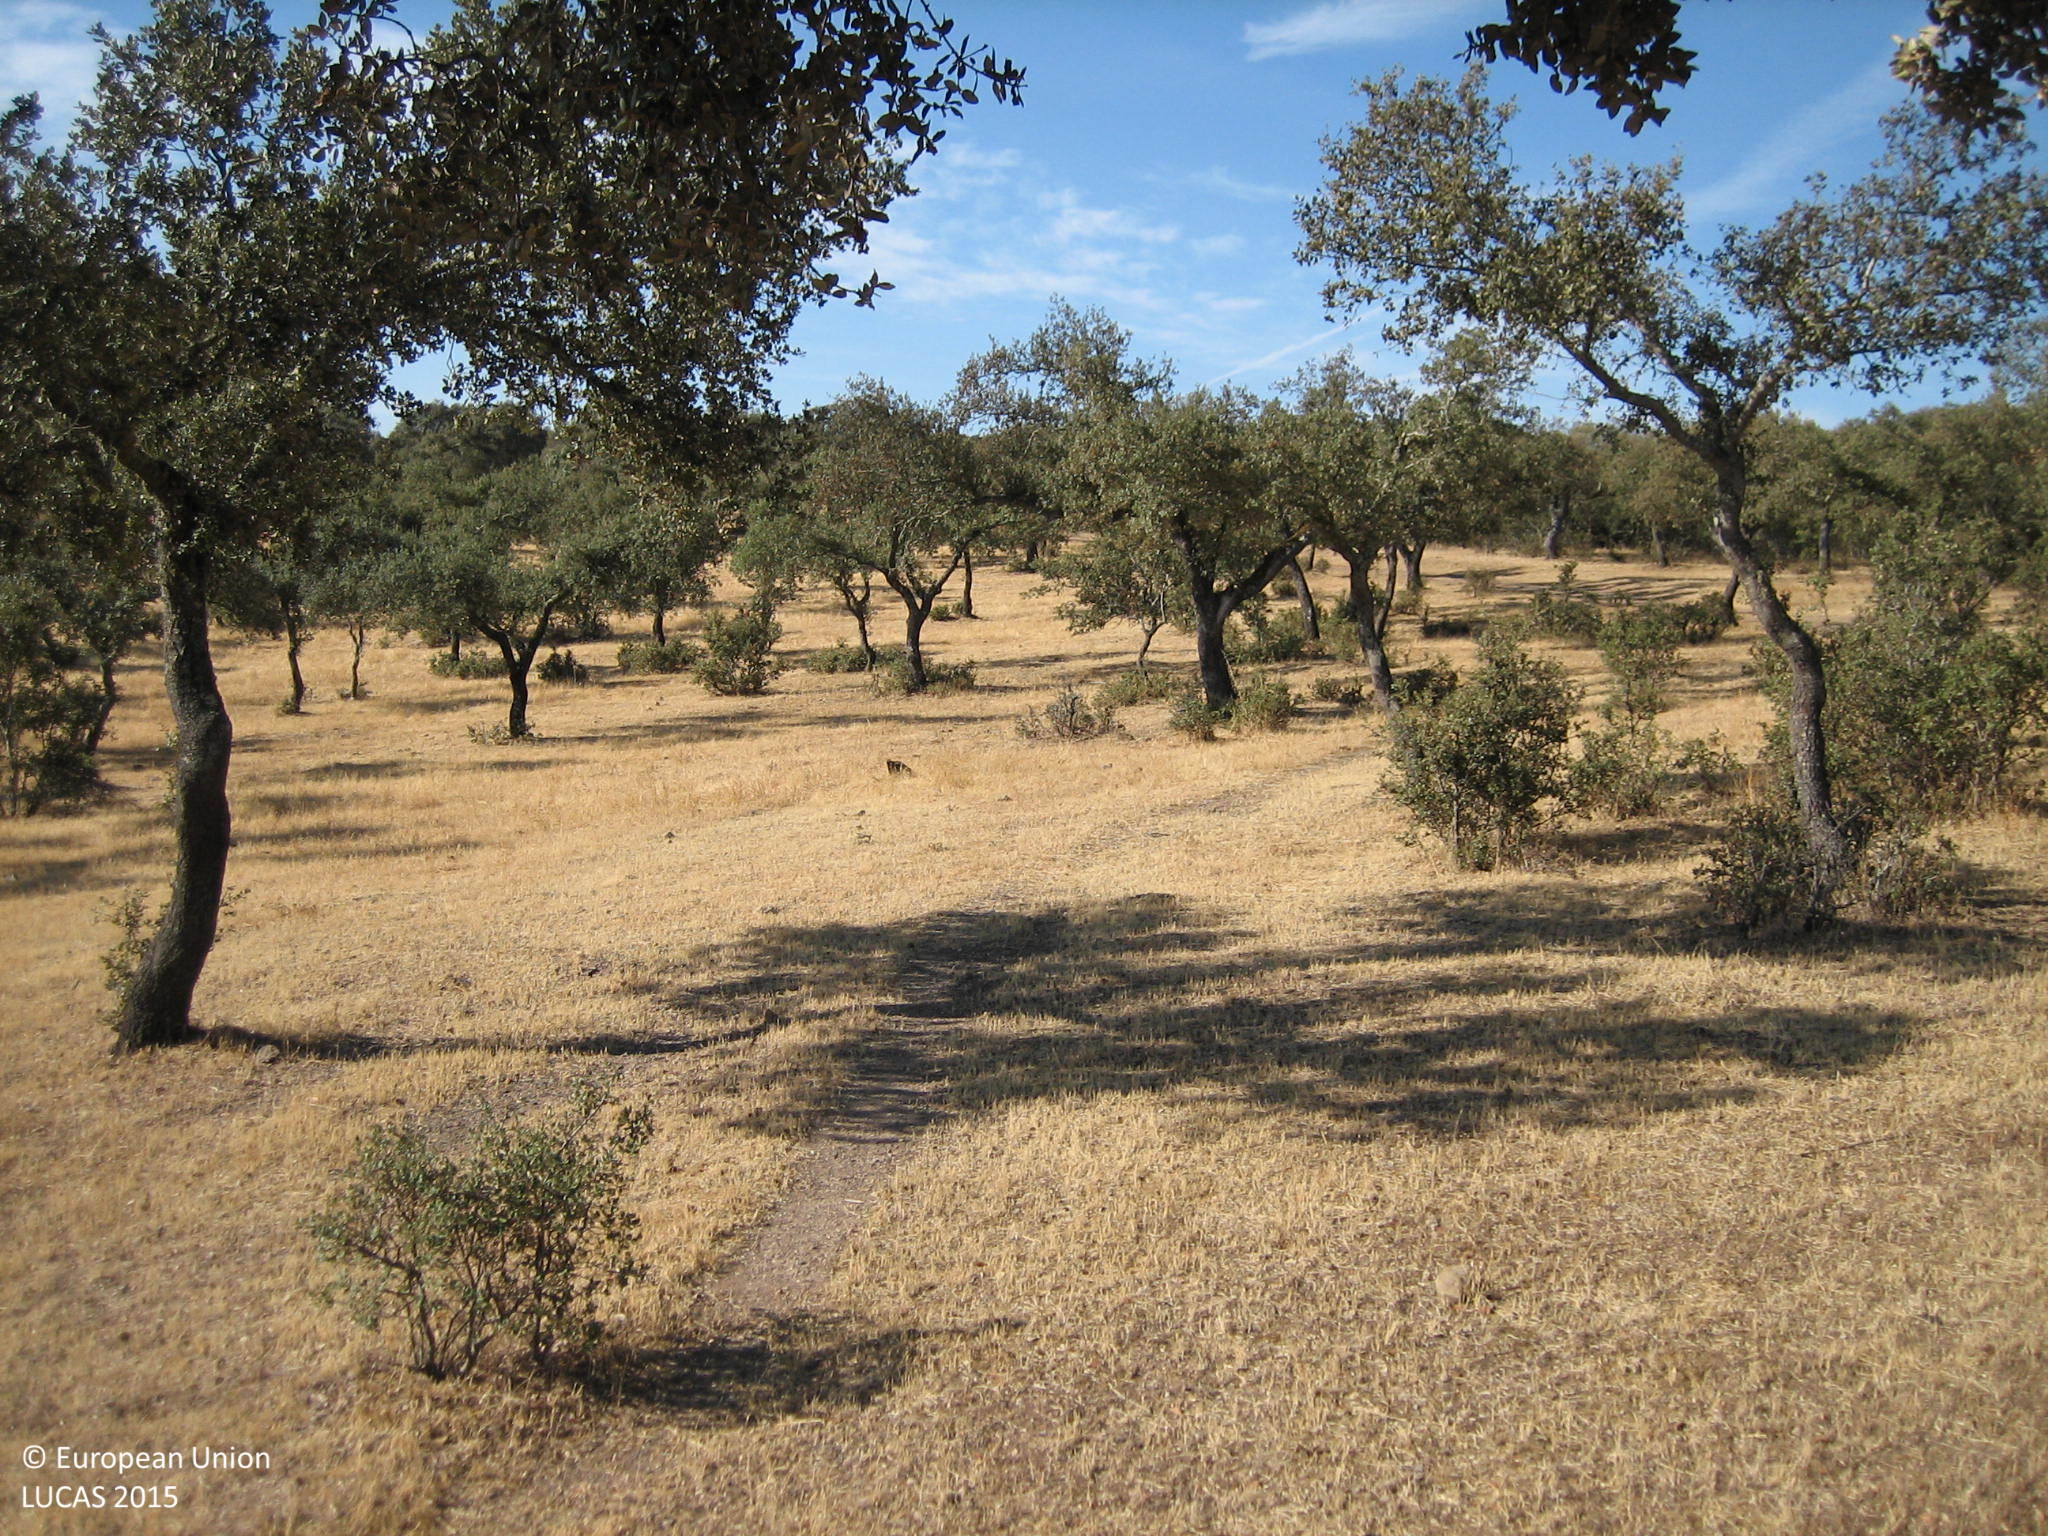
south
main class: Woodland
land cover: Broadleaved woodland
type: broadleaved evergreen forest
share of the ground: 10 - 25 %
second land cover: Grassland without tree/shrub cover
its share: > 75 %
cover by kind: herbaceous plants 80 %, broadleaved forest trees 10 %, unconsolidated bare surface 10 %
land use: Forestry
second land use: Agriculture (excluding fallow land and kitchen gardens)
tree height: < 5 m
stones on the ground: < 10 %
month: August
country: ES
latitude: 38.5427
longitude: -7.2449
